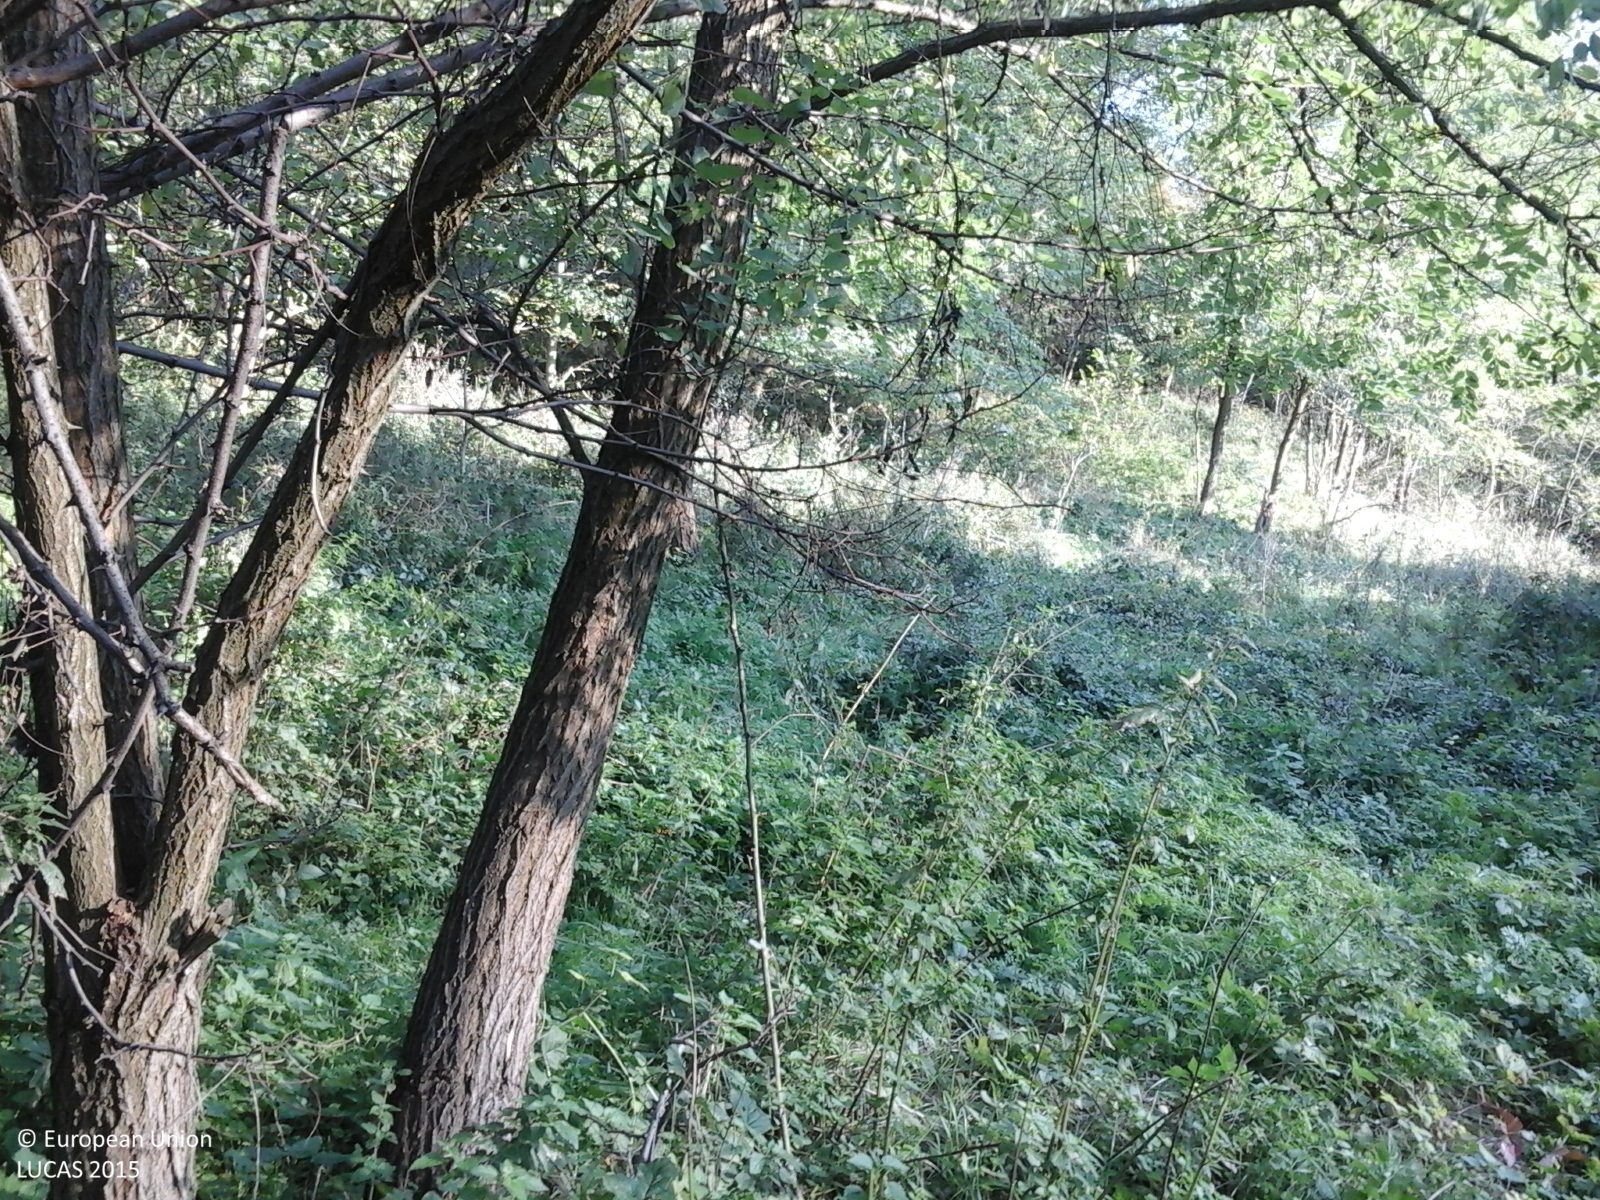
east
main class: Woodland
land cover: Broadleaved woodland
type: exotic forest
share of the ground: > 75 %
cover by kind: broadleaved forest trees 100 %
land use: Forestry
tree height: > 5 m
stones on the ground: < 10 %
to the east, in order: Broadleaved woodland; Lucerne; Tracks; Broadleaved woodland
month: October
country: RO
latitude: 46.0763
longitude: 24.1844
